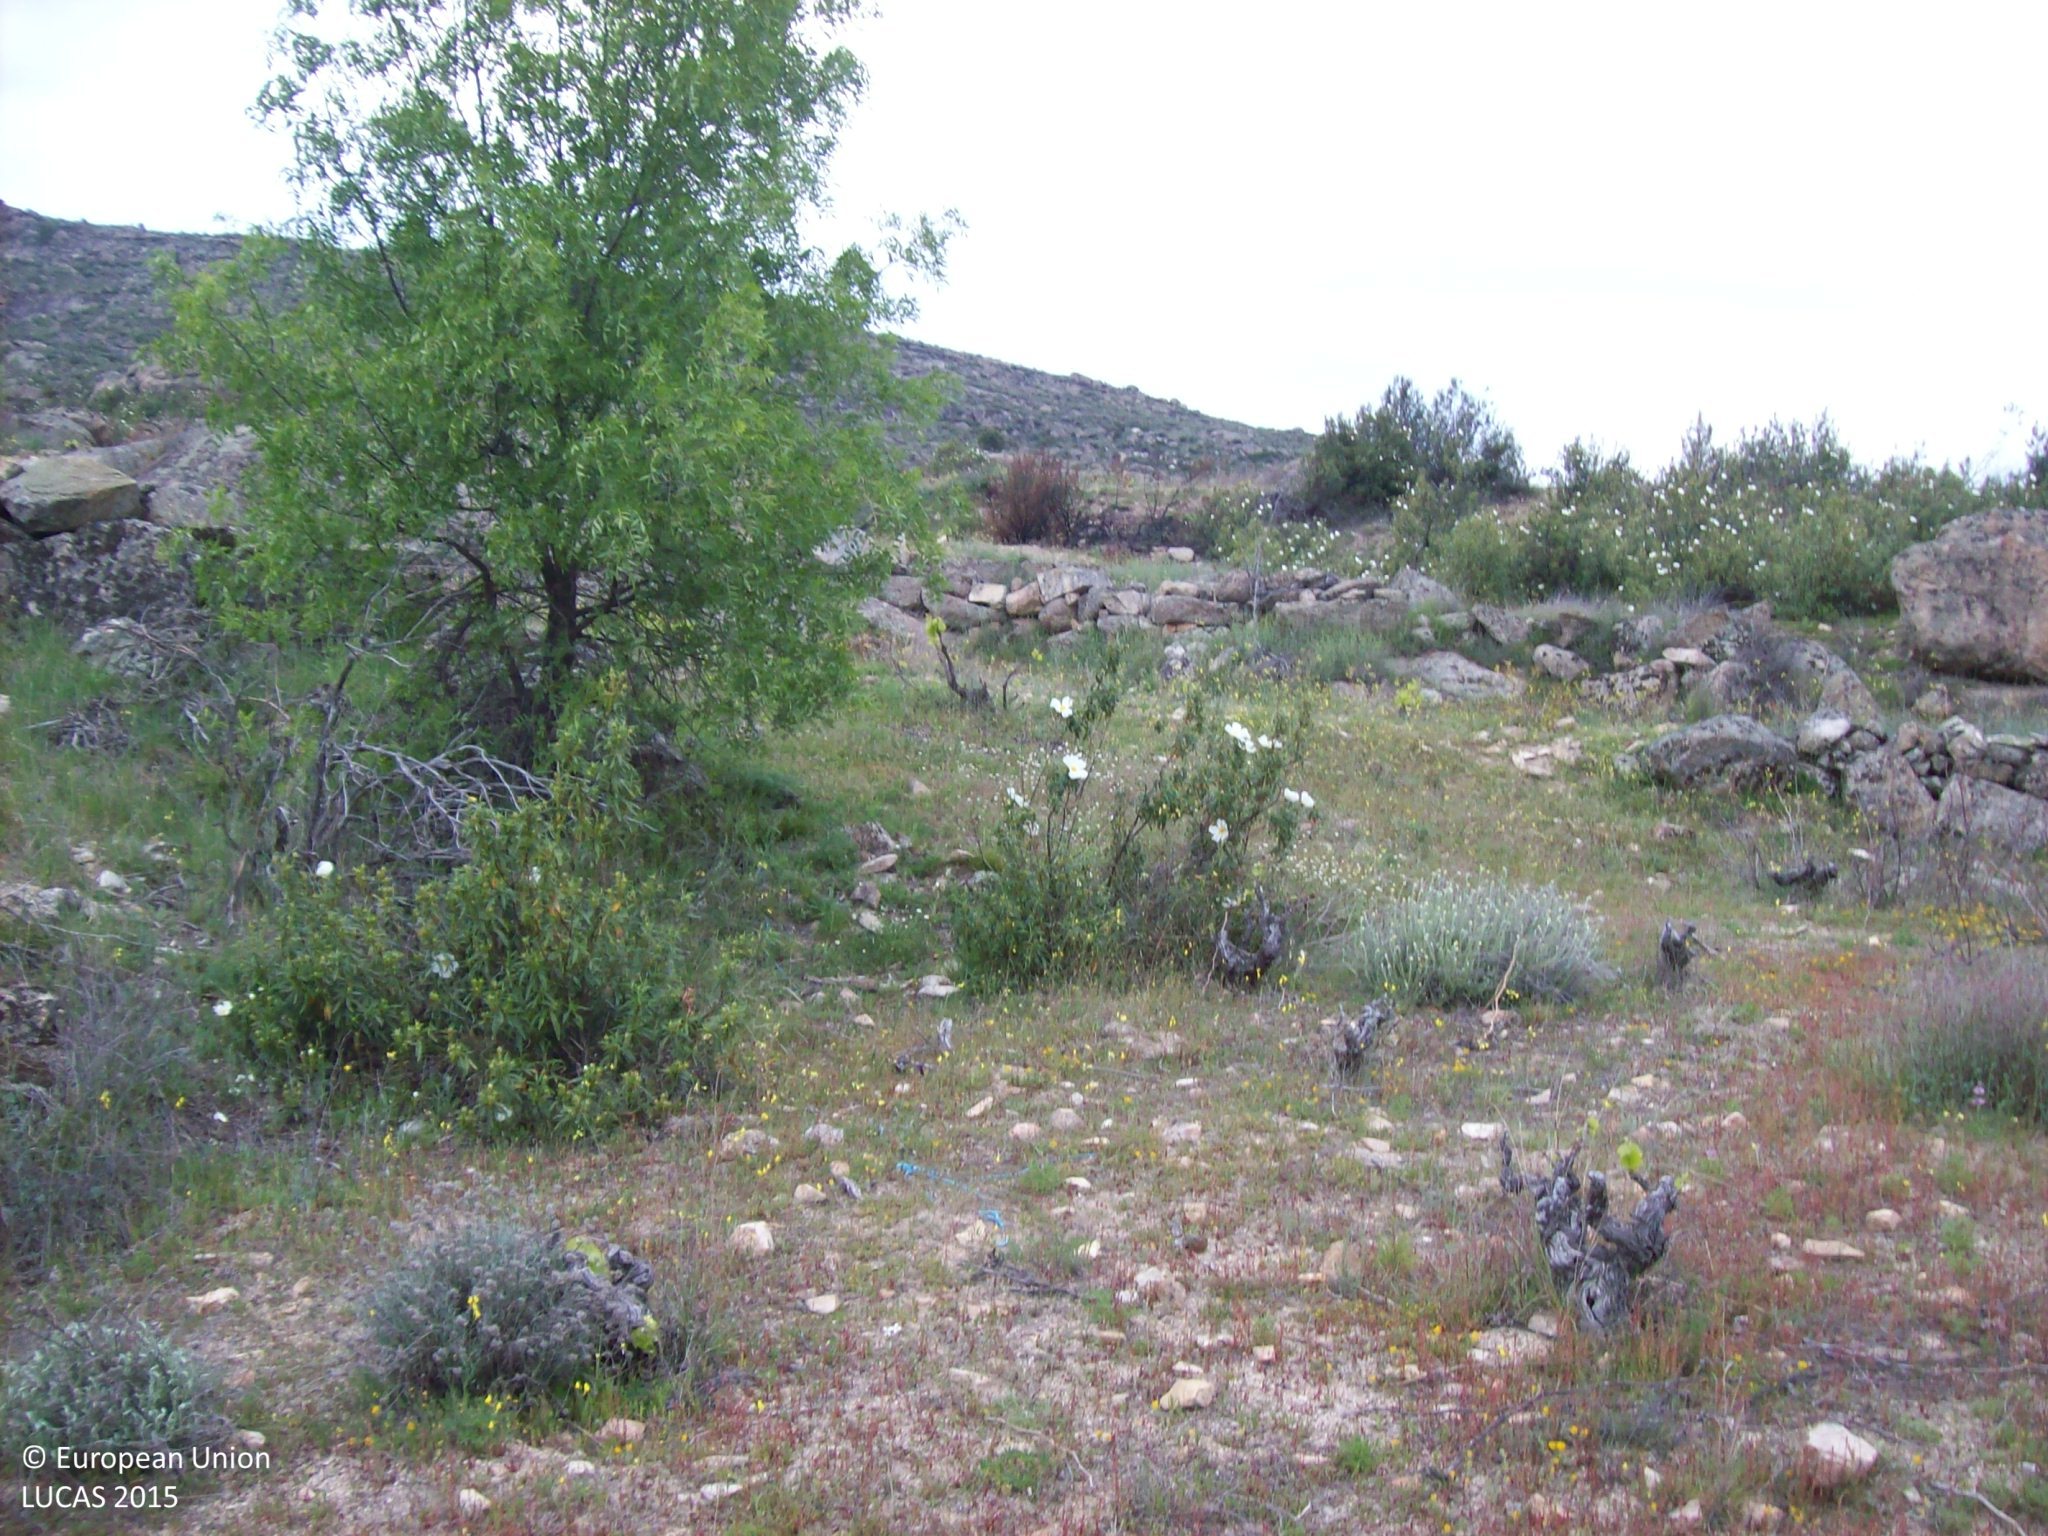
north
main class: Cropland
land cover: Vineyards
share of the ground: 10 - 25 %
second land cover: Shrubland without tree cover
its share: 25 - 50 %
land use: Abandoned areas
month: April
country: ES
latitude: 40.4018
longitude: -4.8175
